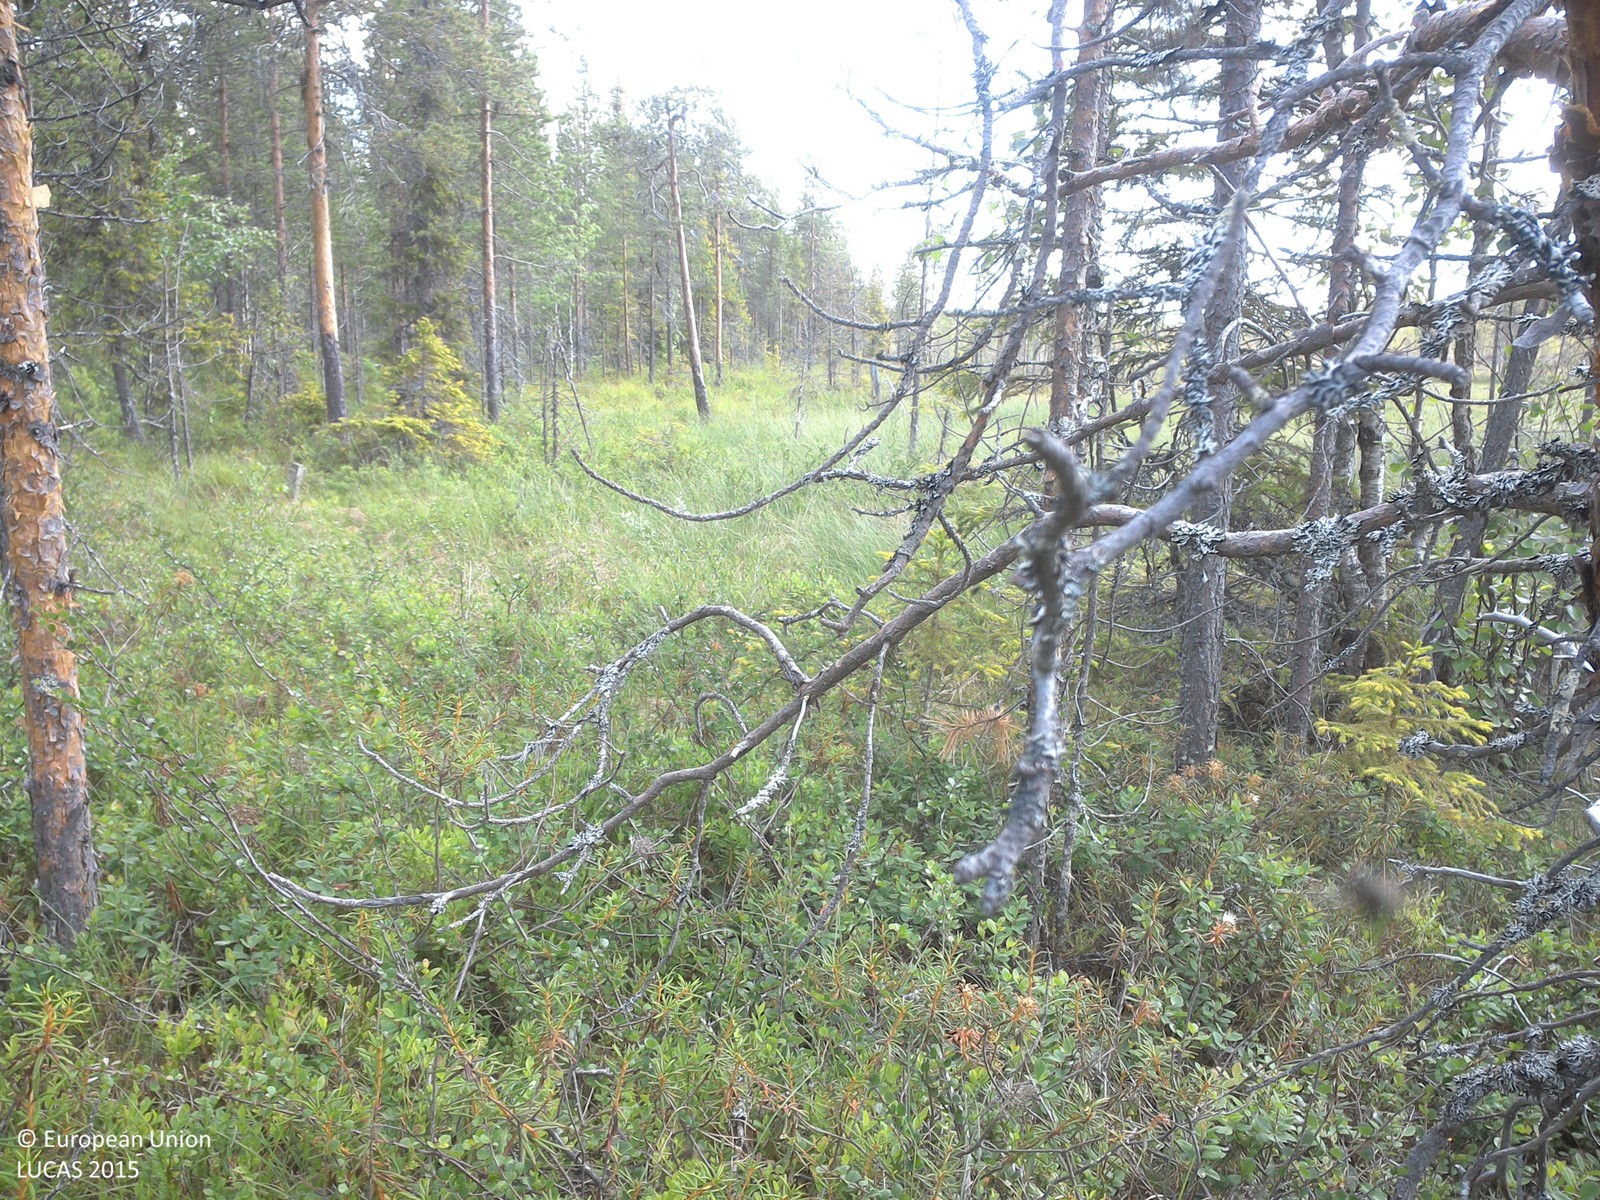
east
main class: Woodland
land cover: Pine dominated mixed woodland
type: boreal forest
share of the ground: 25 - 50 %
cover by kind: herbaceous plants 35 %, shrubs 30 %, coniferous forest trees 20 %, broadleaved forest trees 10 %, lichens and mosses 5 %
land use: Forestry
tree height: > 5 m
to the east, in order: Pine dominated mixed woodland; Inland marshes; Groves; Paved roads, cycling and walking lanes; Groves
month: July
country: SE
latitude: 67.4386
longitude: 23.3512
